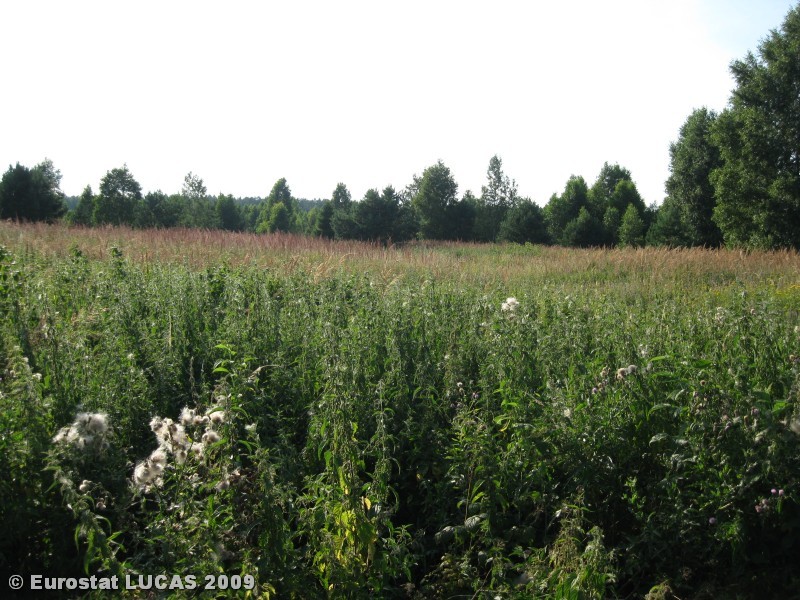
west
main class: Grassland
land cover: Spontaneously vegetated surfaces
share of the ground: > 75 %
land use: Unused
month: August
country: LT
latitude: 54.8326
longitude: 23.4850
